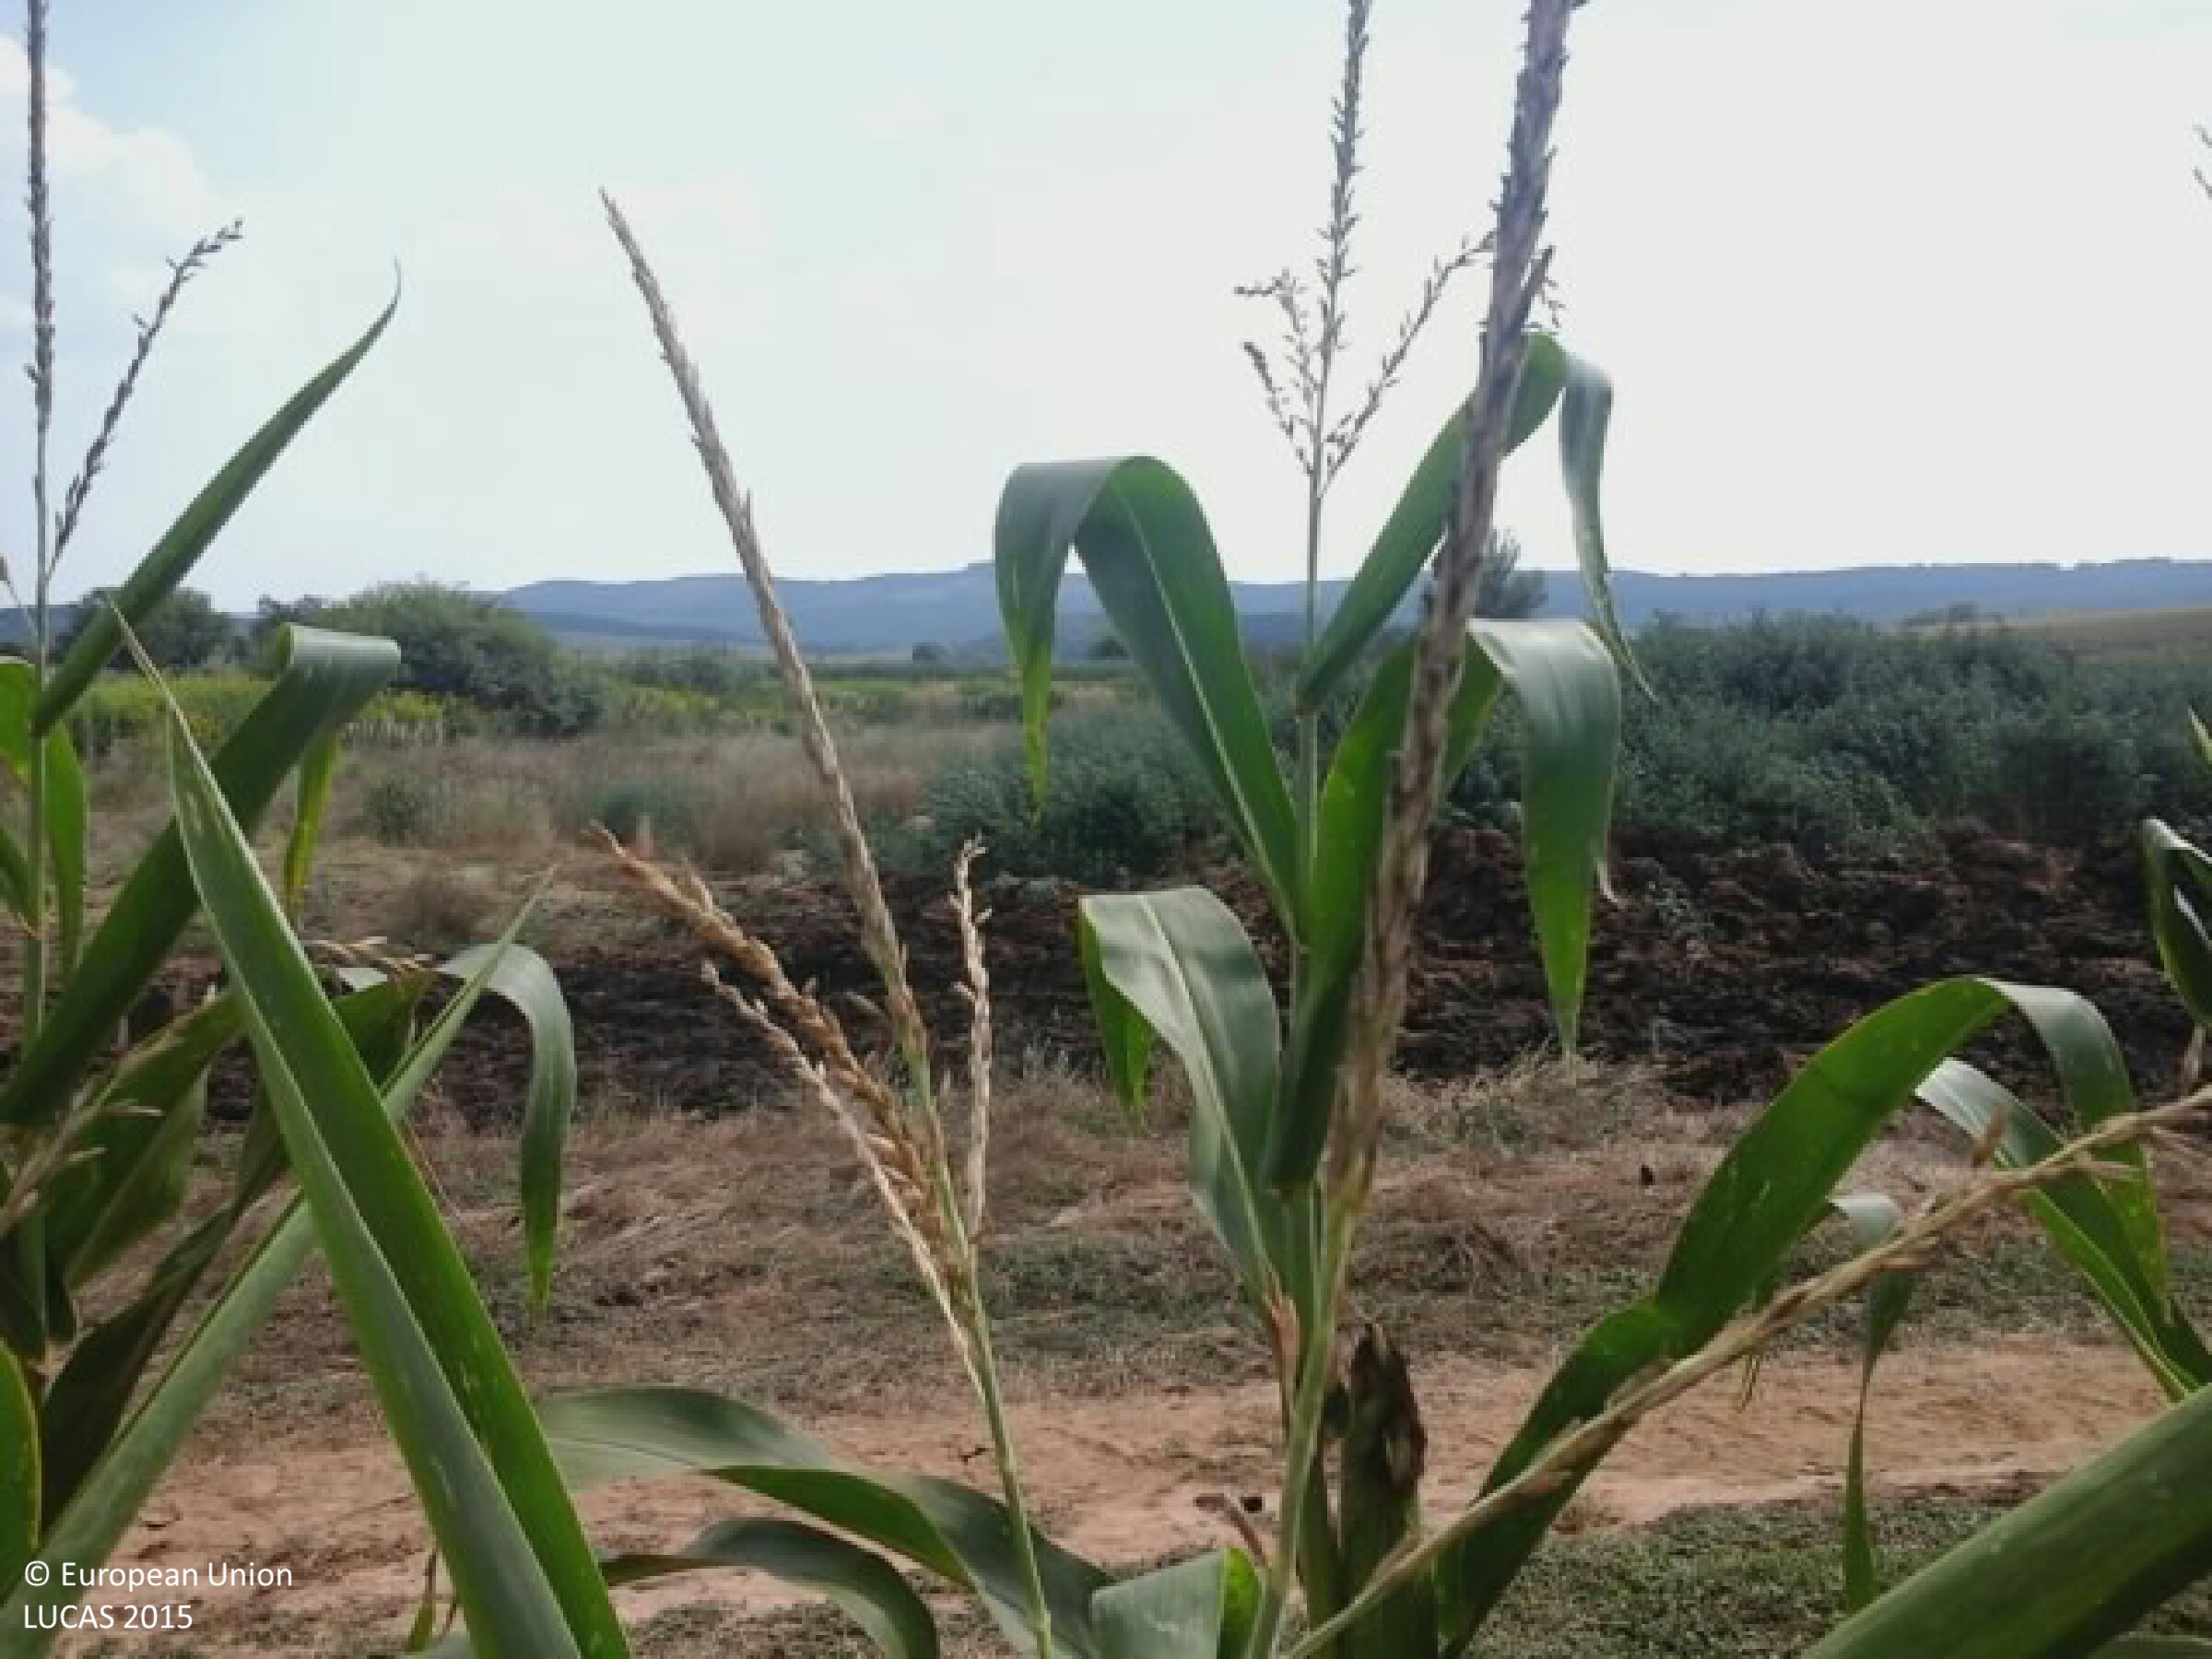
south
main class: Cropland
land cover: Maize
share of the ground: > 75 %
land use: Agriculture (excluding fallow land and kitchen gardens)
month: August
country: HU
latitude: 46.3233
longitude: 18.2296
